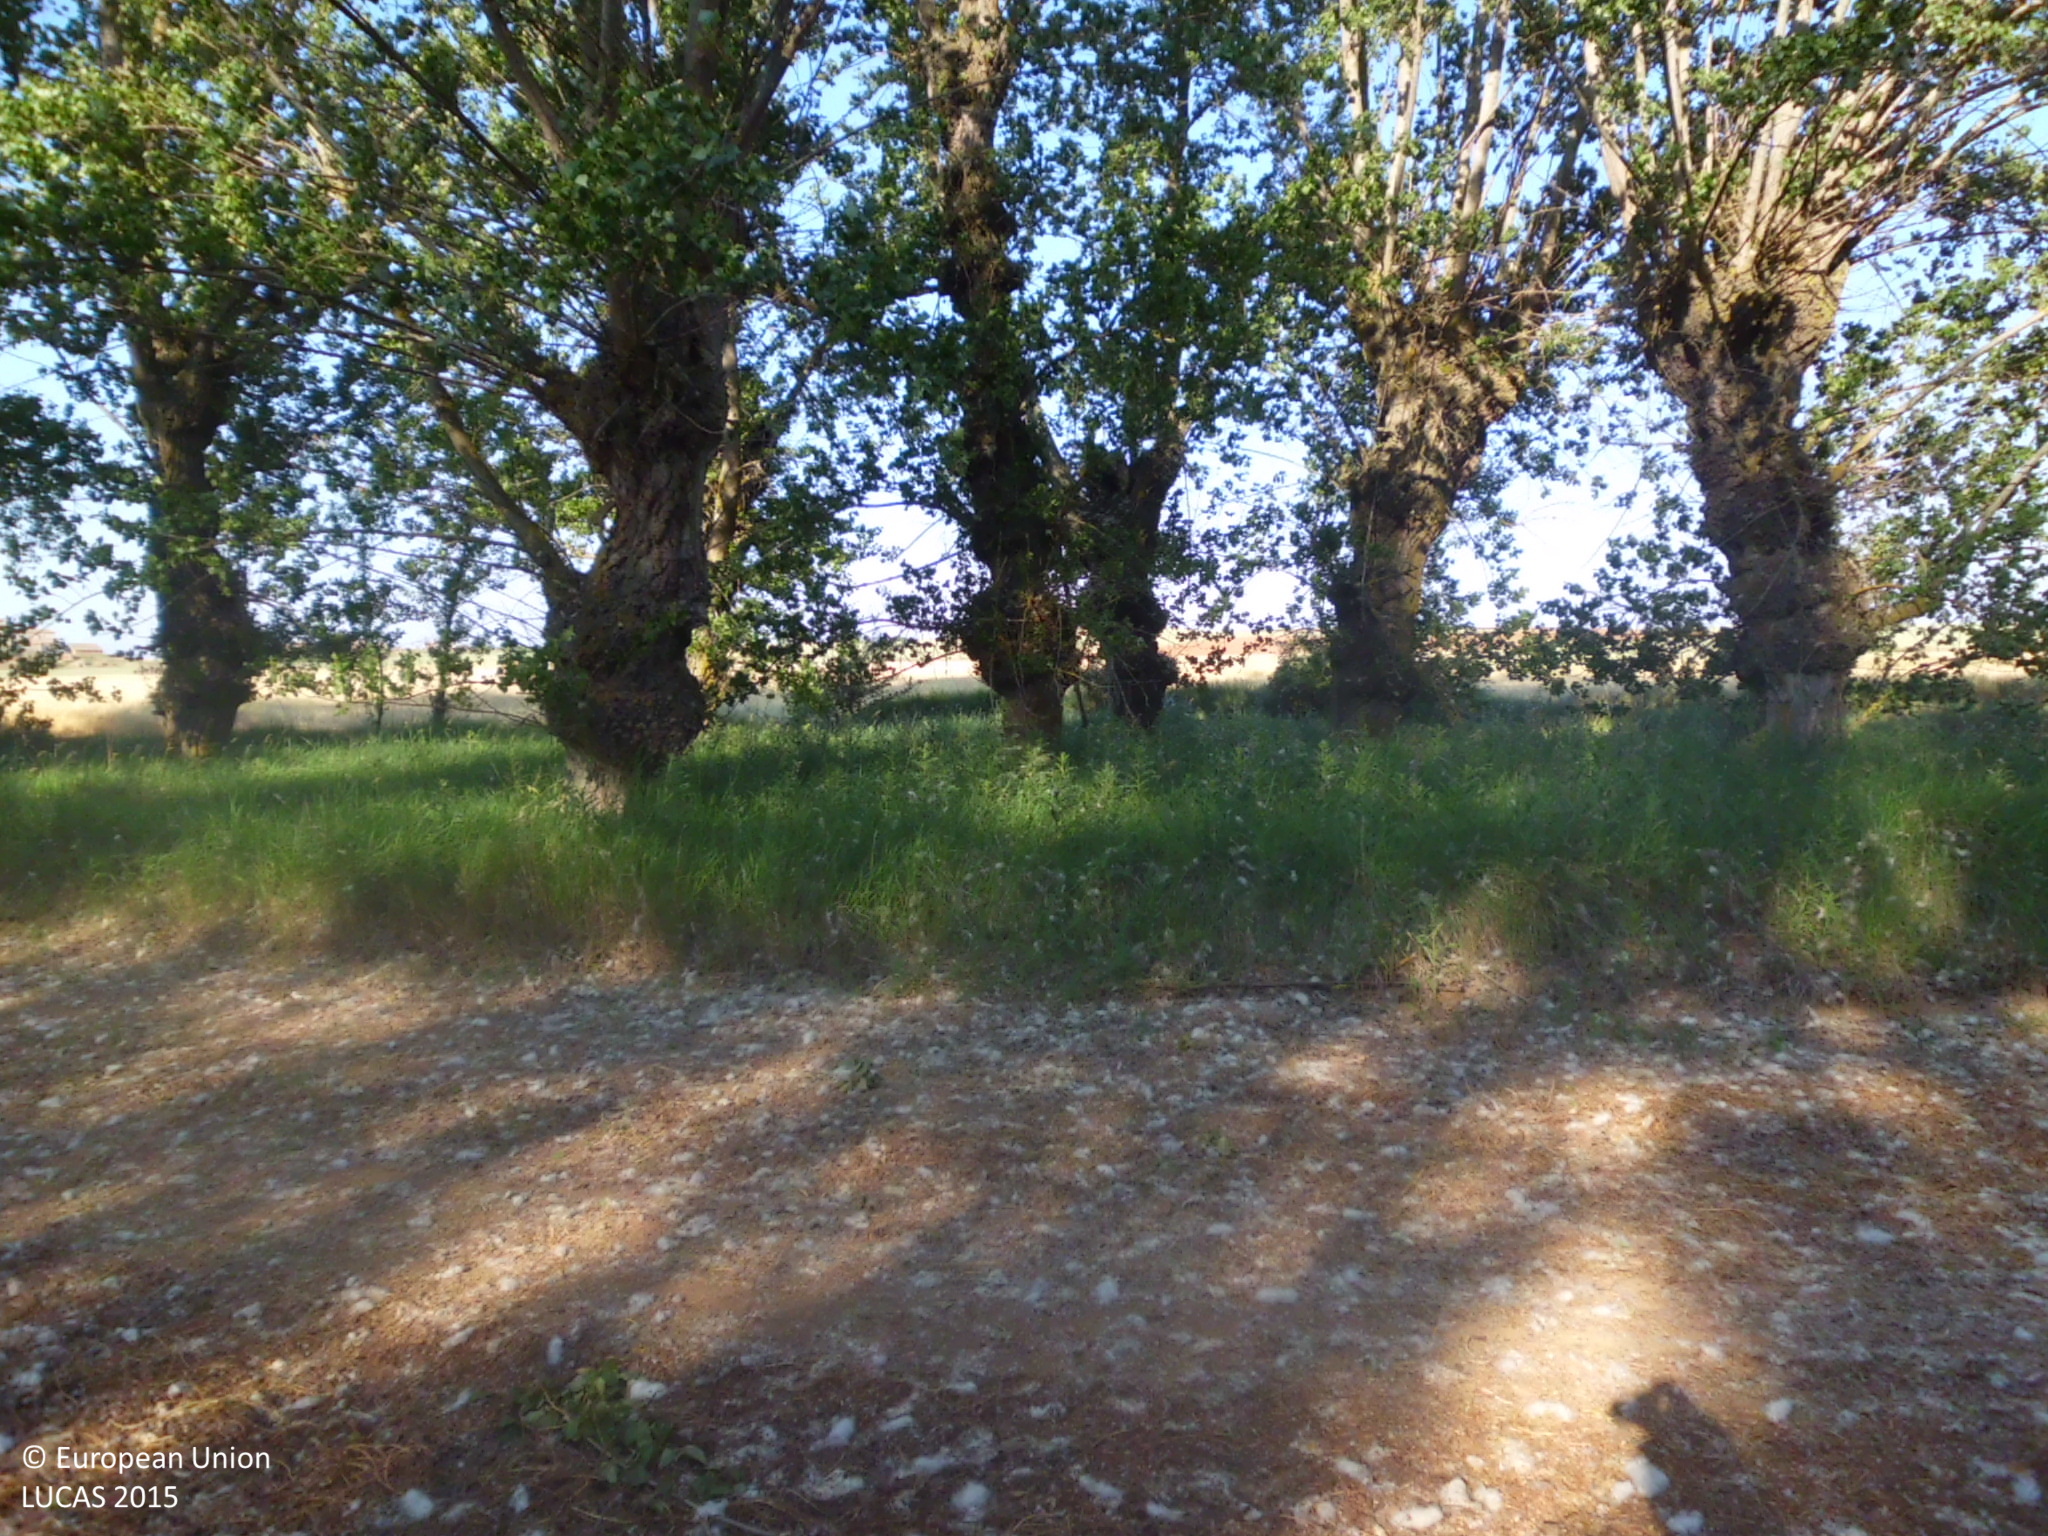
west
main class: Cropland
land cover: Mixed cereals for fodder
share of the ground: 50 - 75 %
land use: Agriculture (excluding fallow land and kitchen gardens)
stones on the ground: < 10 %
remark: Harvested field
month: June
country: ES
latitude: 42.4787
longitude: -4.0196
